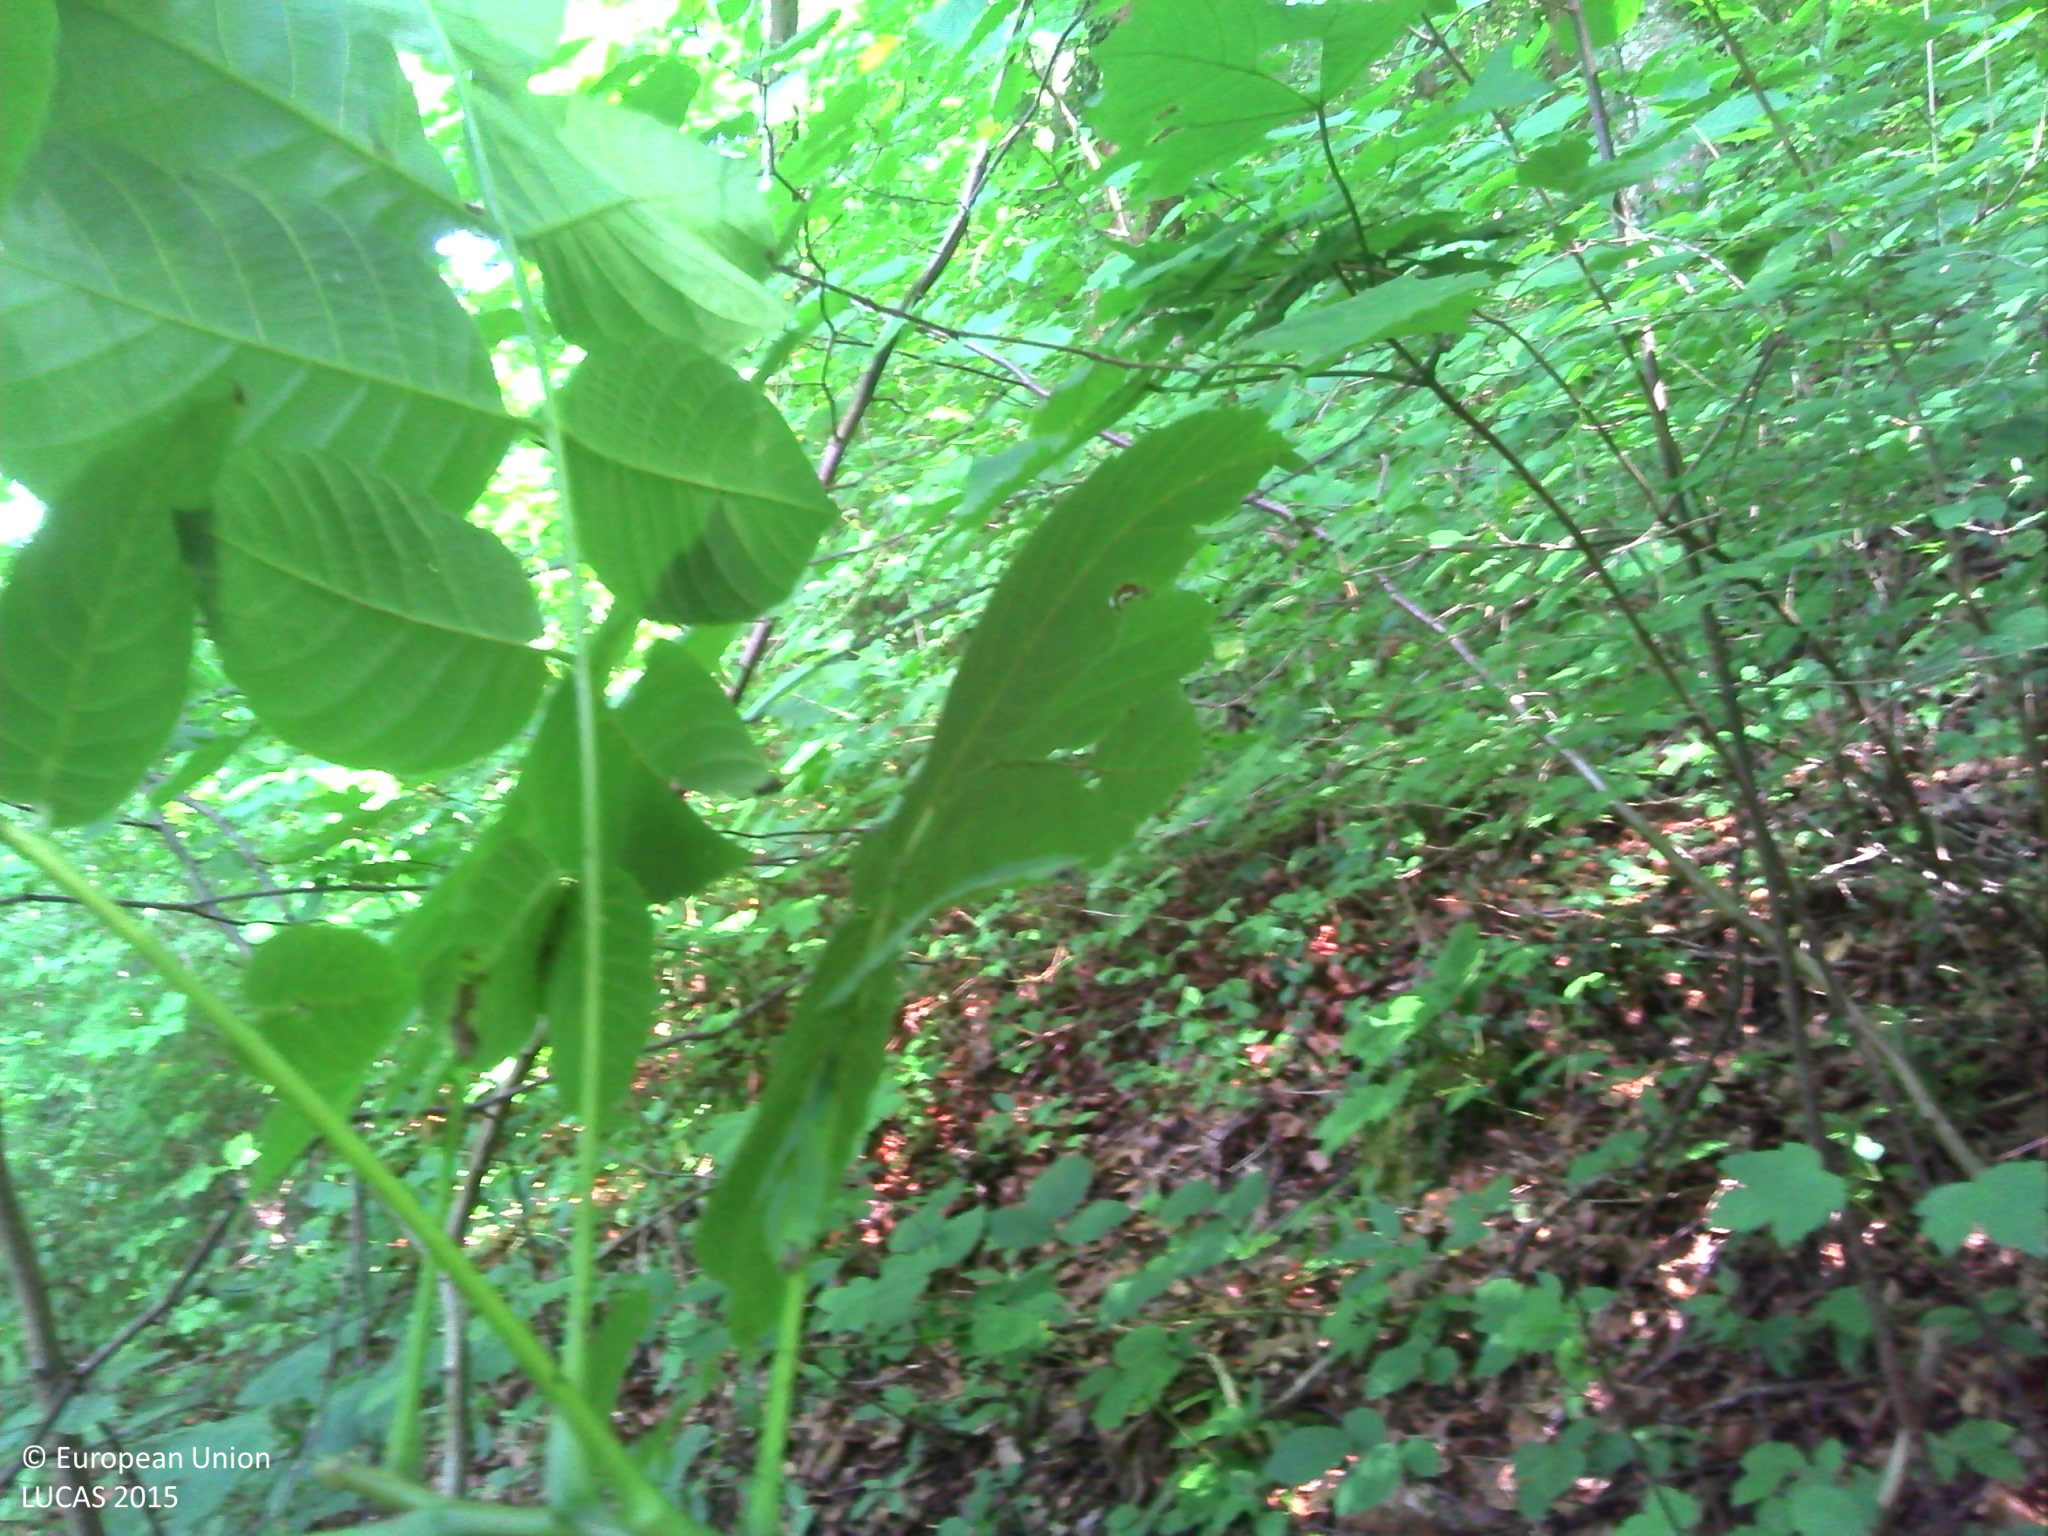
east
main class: Woodland
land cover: Spruce dominated mixed woodland
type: mountainous beech forest
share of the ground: > 75 %
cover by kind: broadleaved forest trees 40 %, coniferous forest trees 35 %, herbaceous plants 20 %, lichens and mosses 5 %
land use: Forestry
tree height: > 5 m
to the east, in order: Spruce dominated mixed woodland; Rivers and streams; Fences; Grassland without tree/shrub cover; Fences; Spruce dominated mixed woodland; Ditches and canals; Spruce dominated mixed woodland
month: July
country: FR
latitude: 45.9562
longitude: 6.1203
